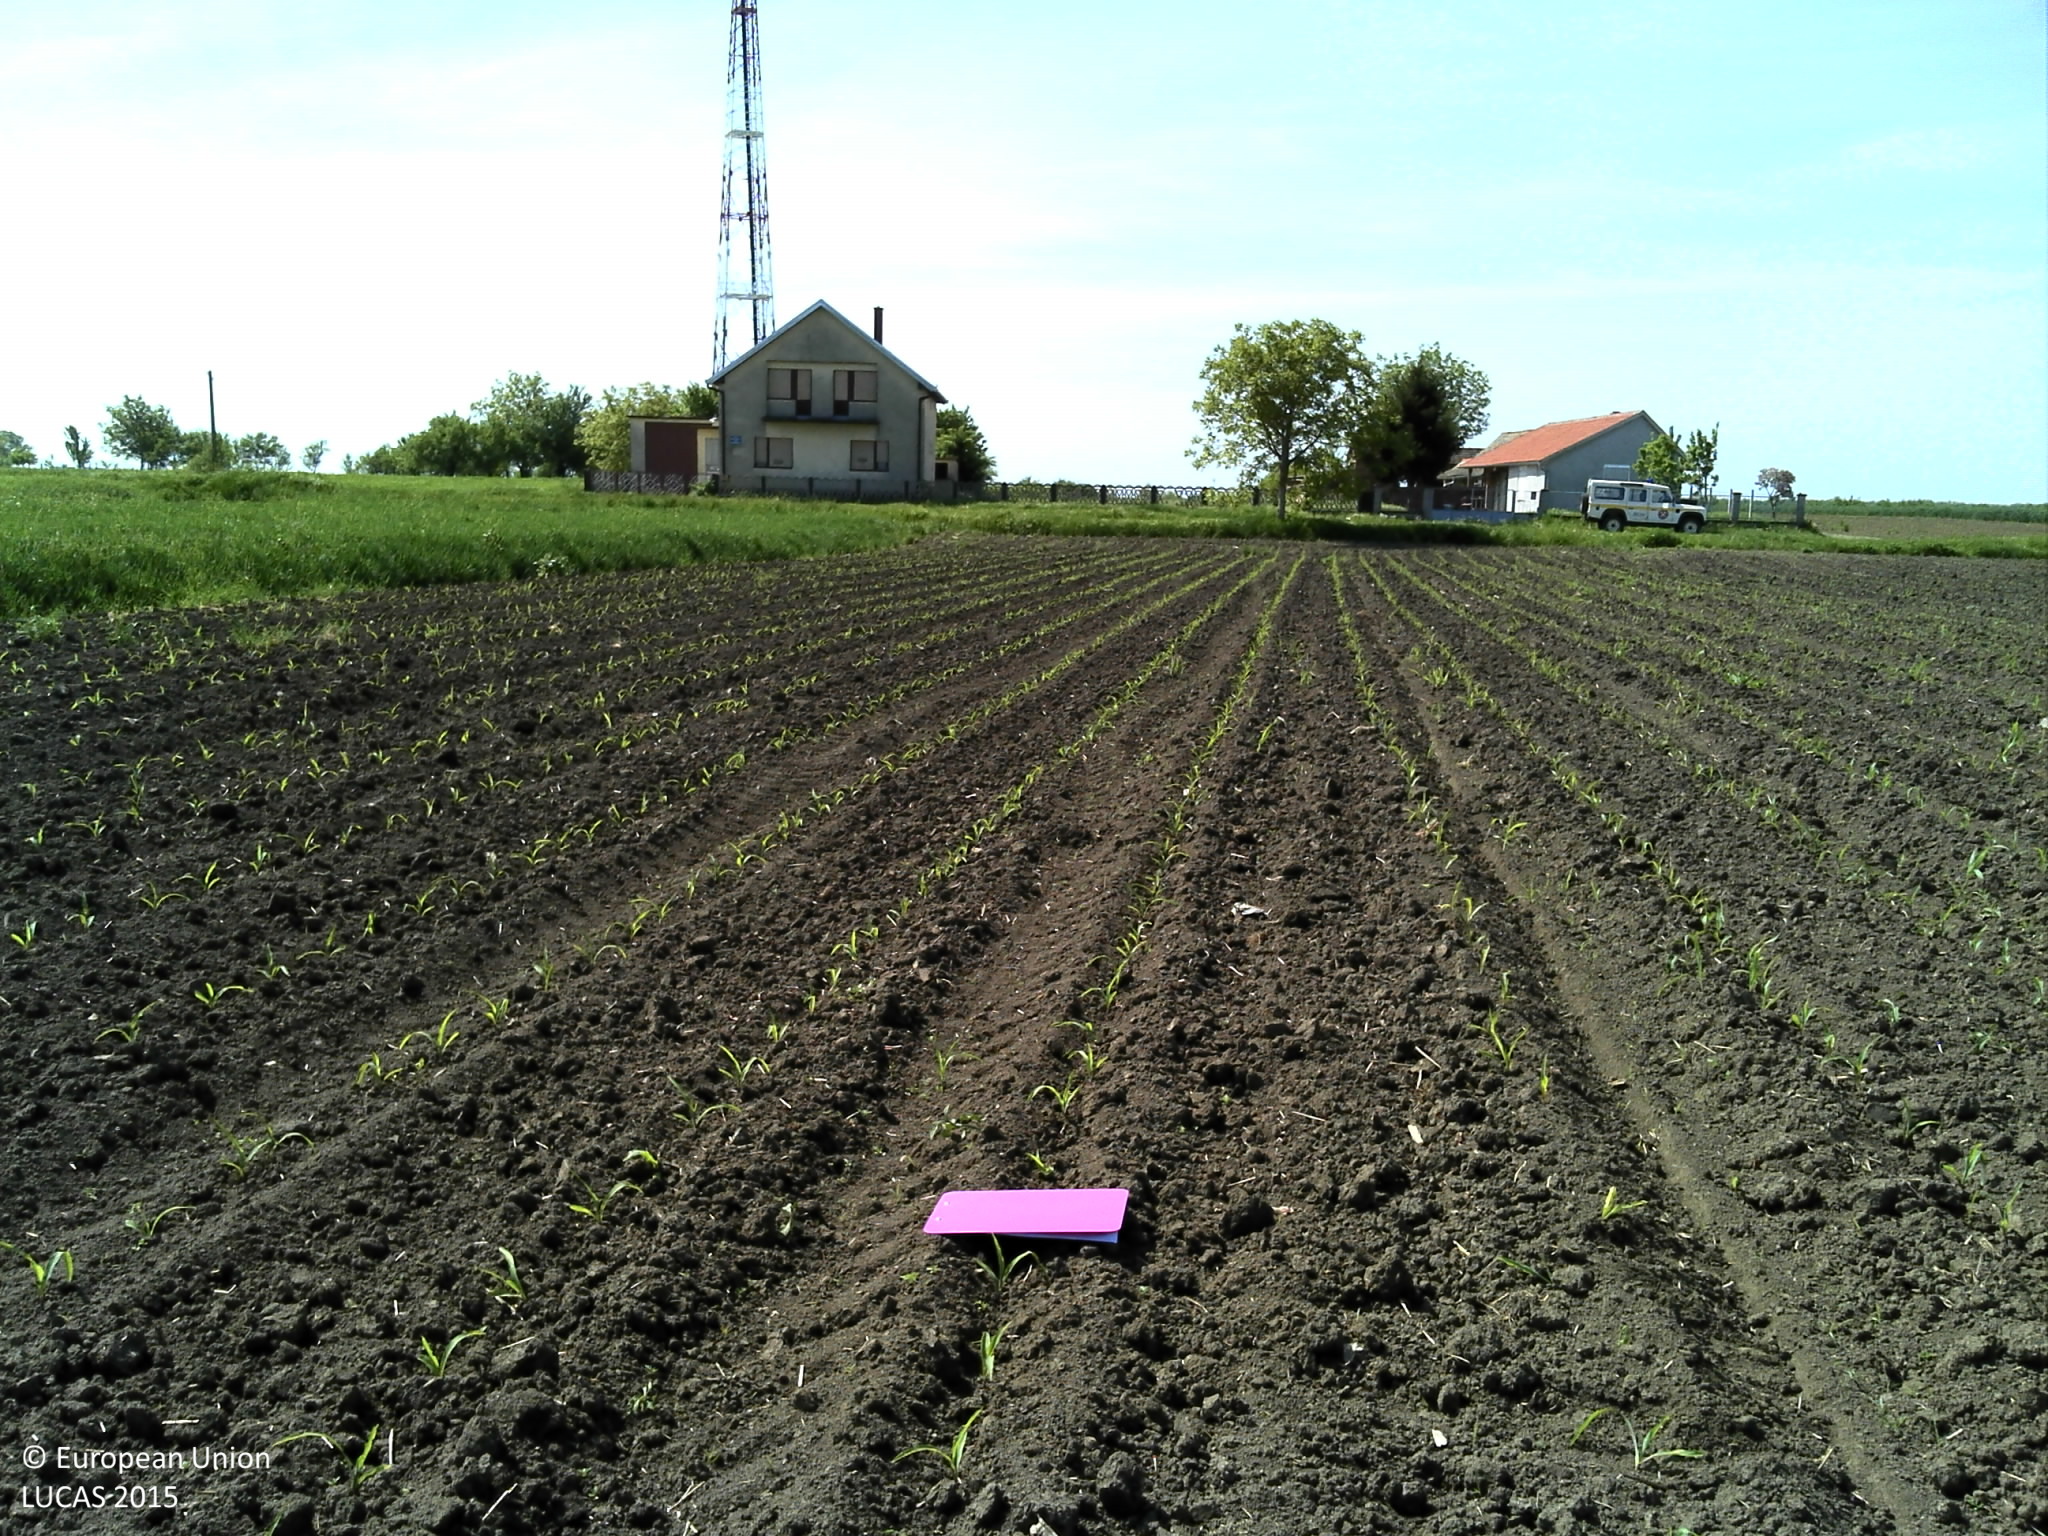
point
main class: Cropland
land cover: Maize
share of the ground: < 10 %
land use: Agriculture (excluding fallow land and kitchen gardens)
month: May
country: HR
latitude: 45.4187
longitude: 18.8900
